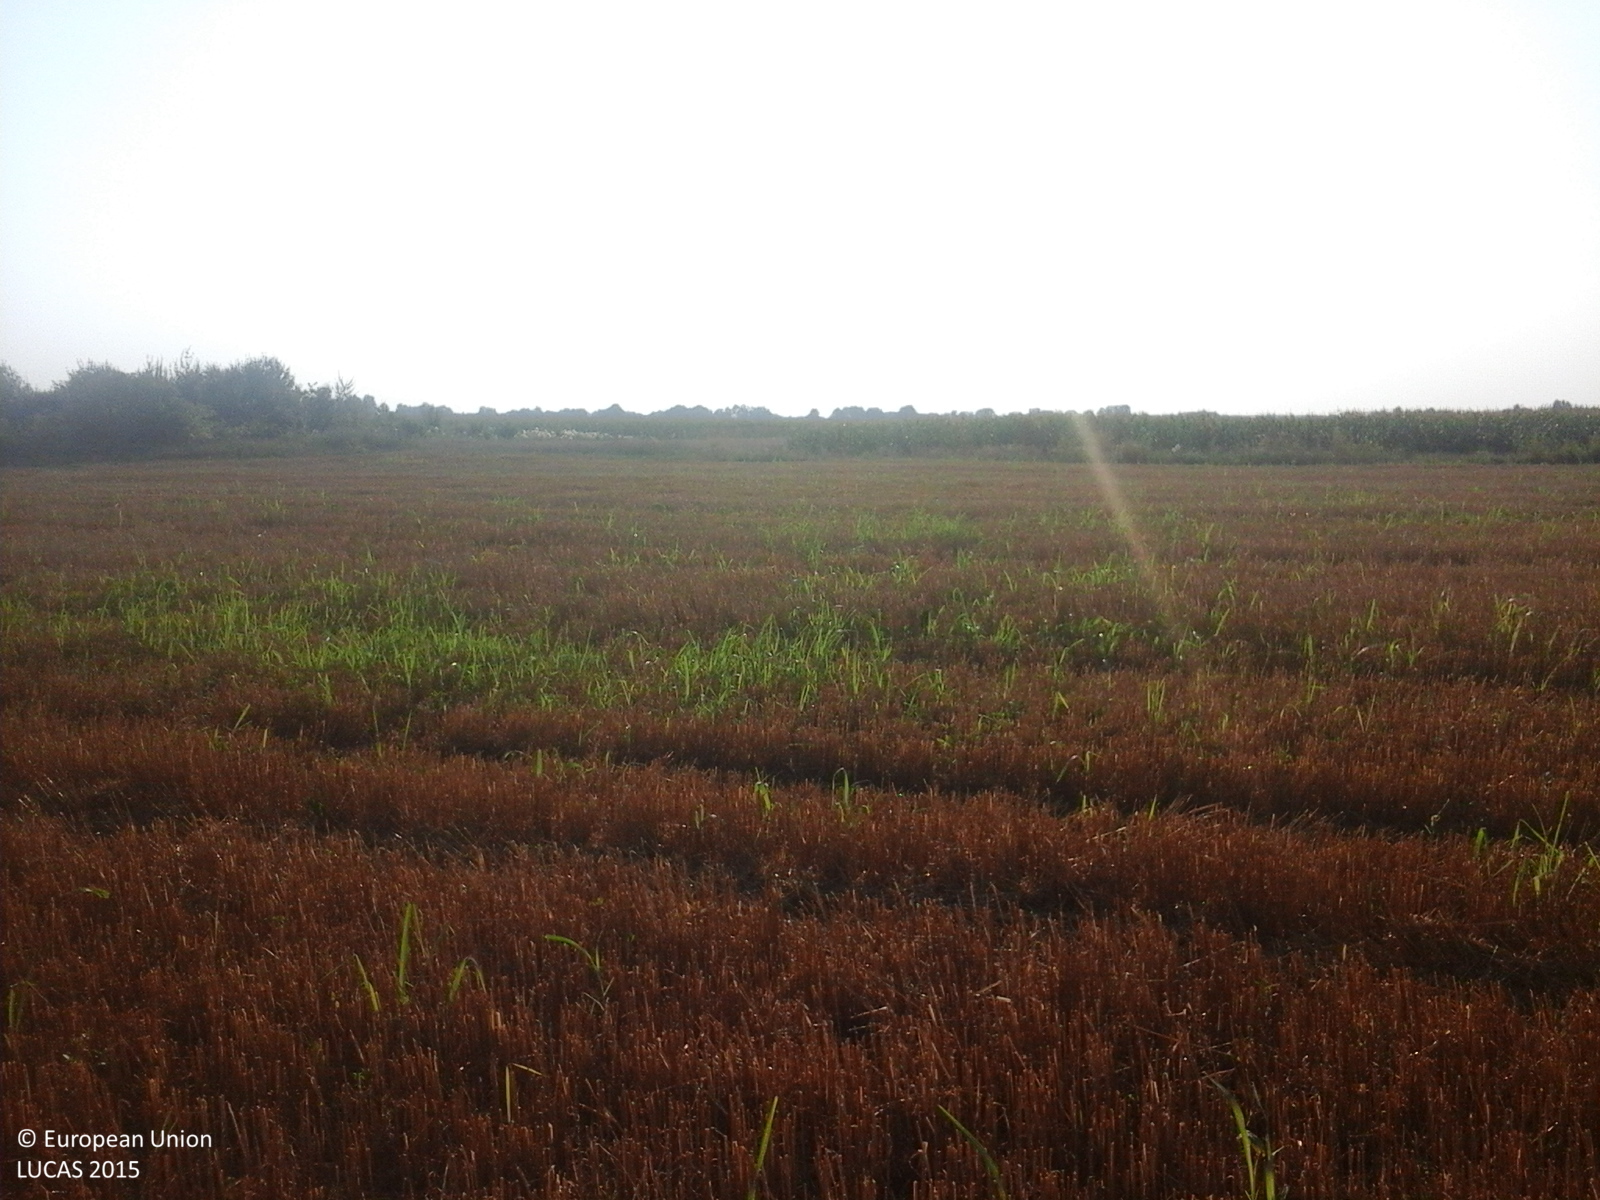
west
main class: Cropland
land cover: Common wheat
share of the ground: 25 - 50 %
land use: Agriculture (excluding fallow land and kitchen gardens)
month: July
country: RO
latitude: 44.6137
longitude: 25.5820
